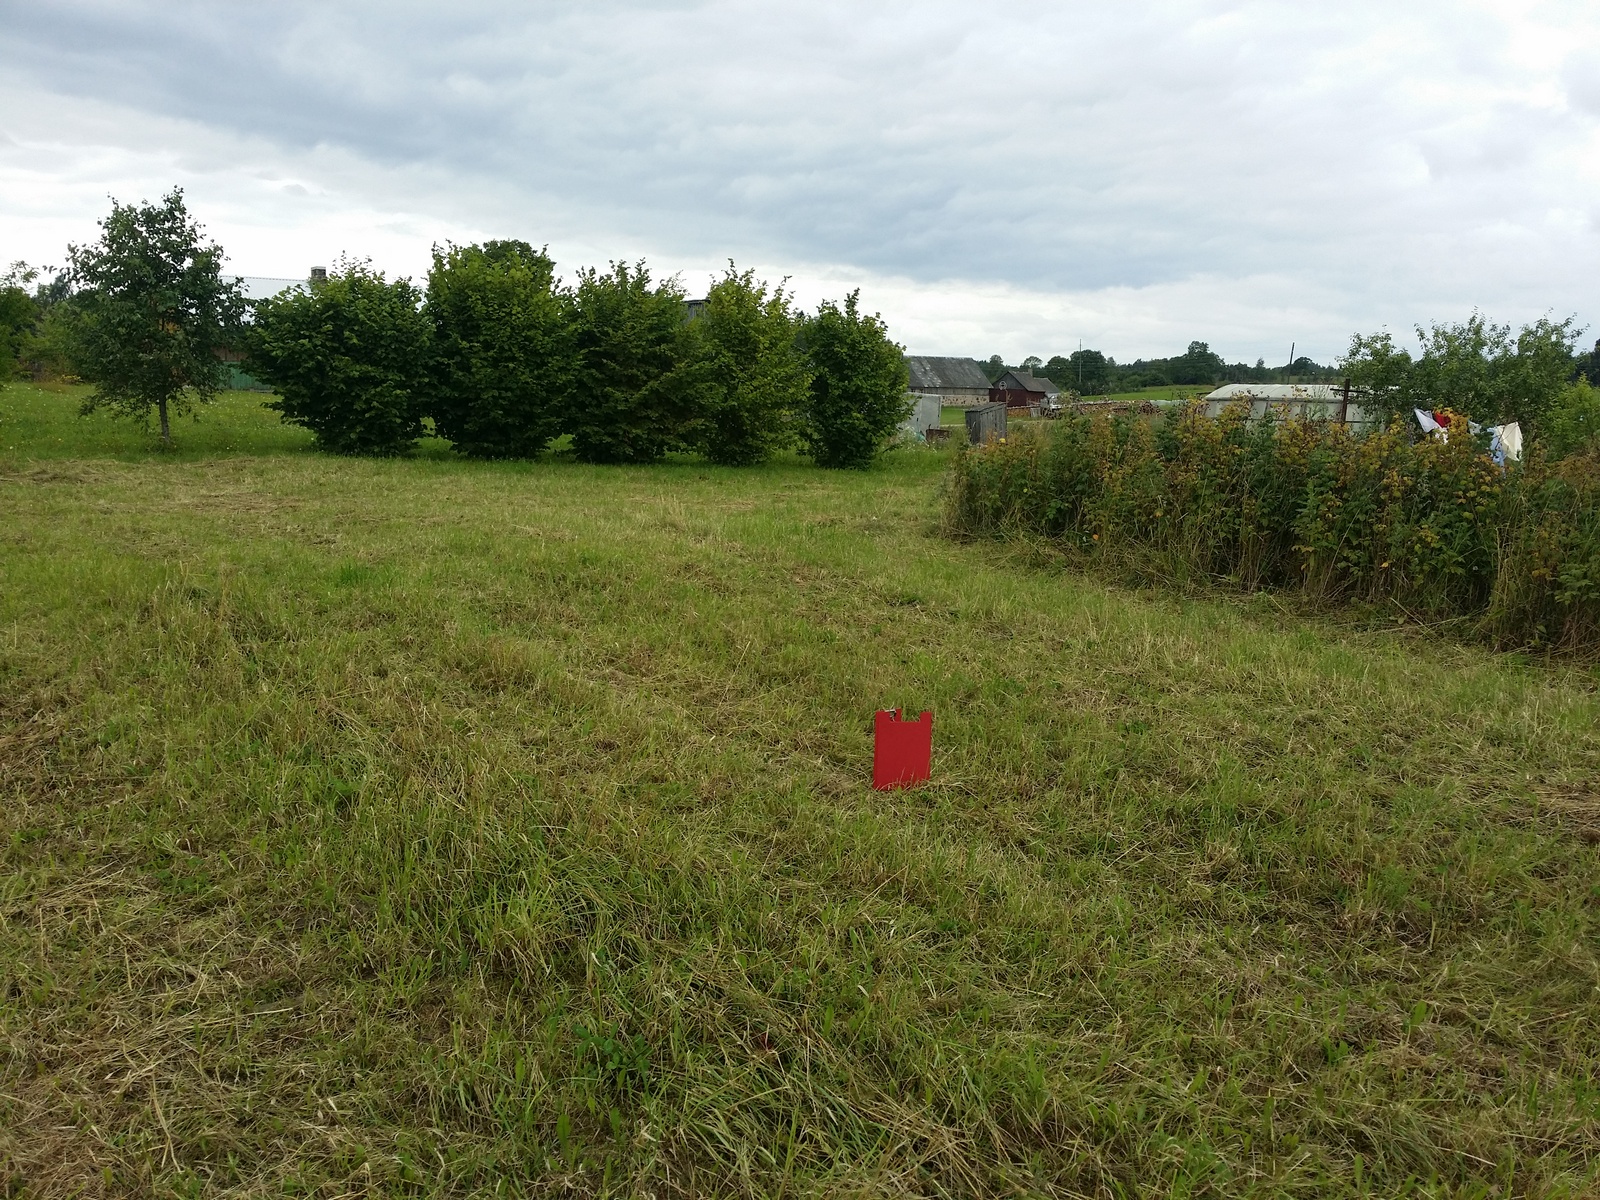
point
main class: Grassland
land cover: Grassland without tree/shrub cover
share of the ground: > 75 %
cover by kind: herbaceous plants 90 %, unconsolidated bare surface 10 %
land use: Agriculture (excluding fallow land and kitchen gardens)
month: August
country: LV
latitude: 57.1932
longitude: 26.7500
